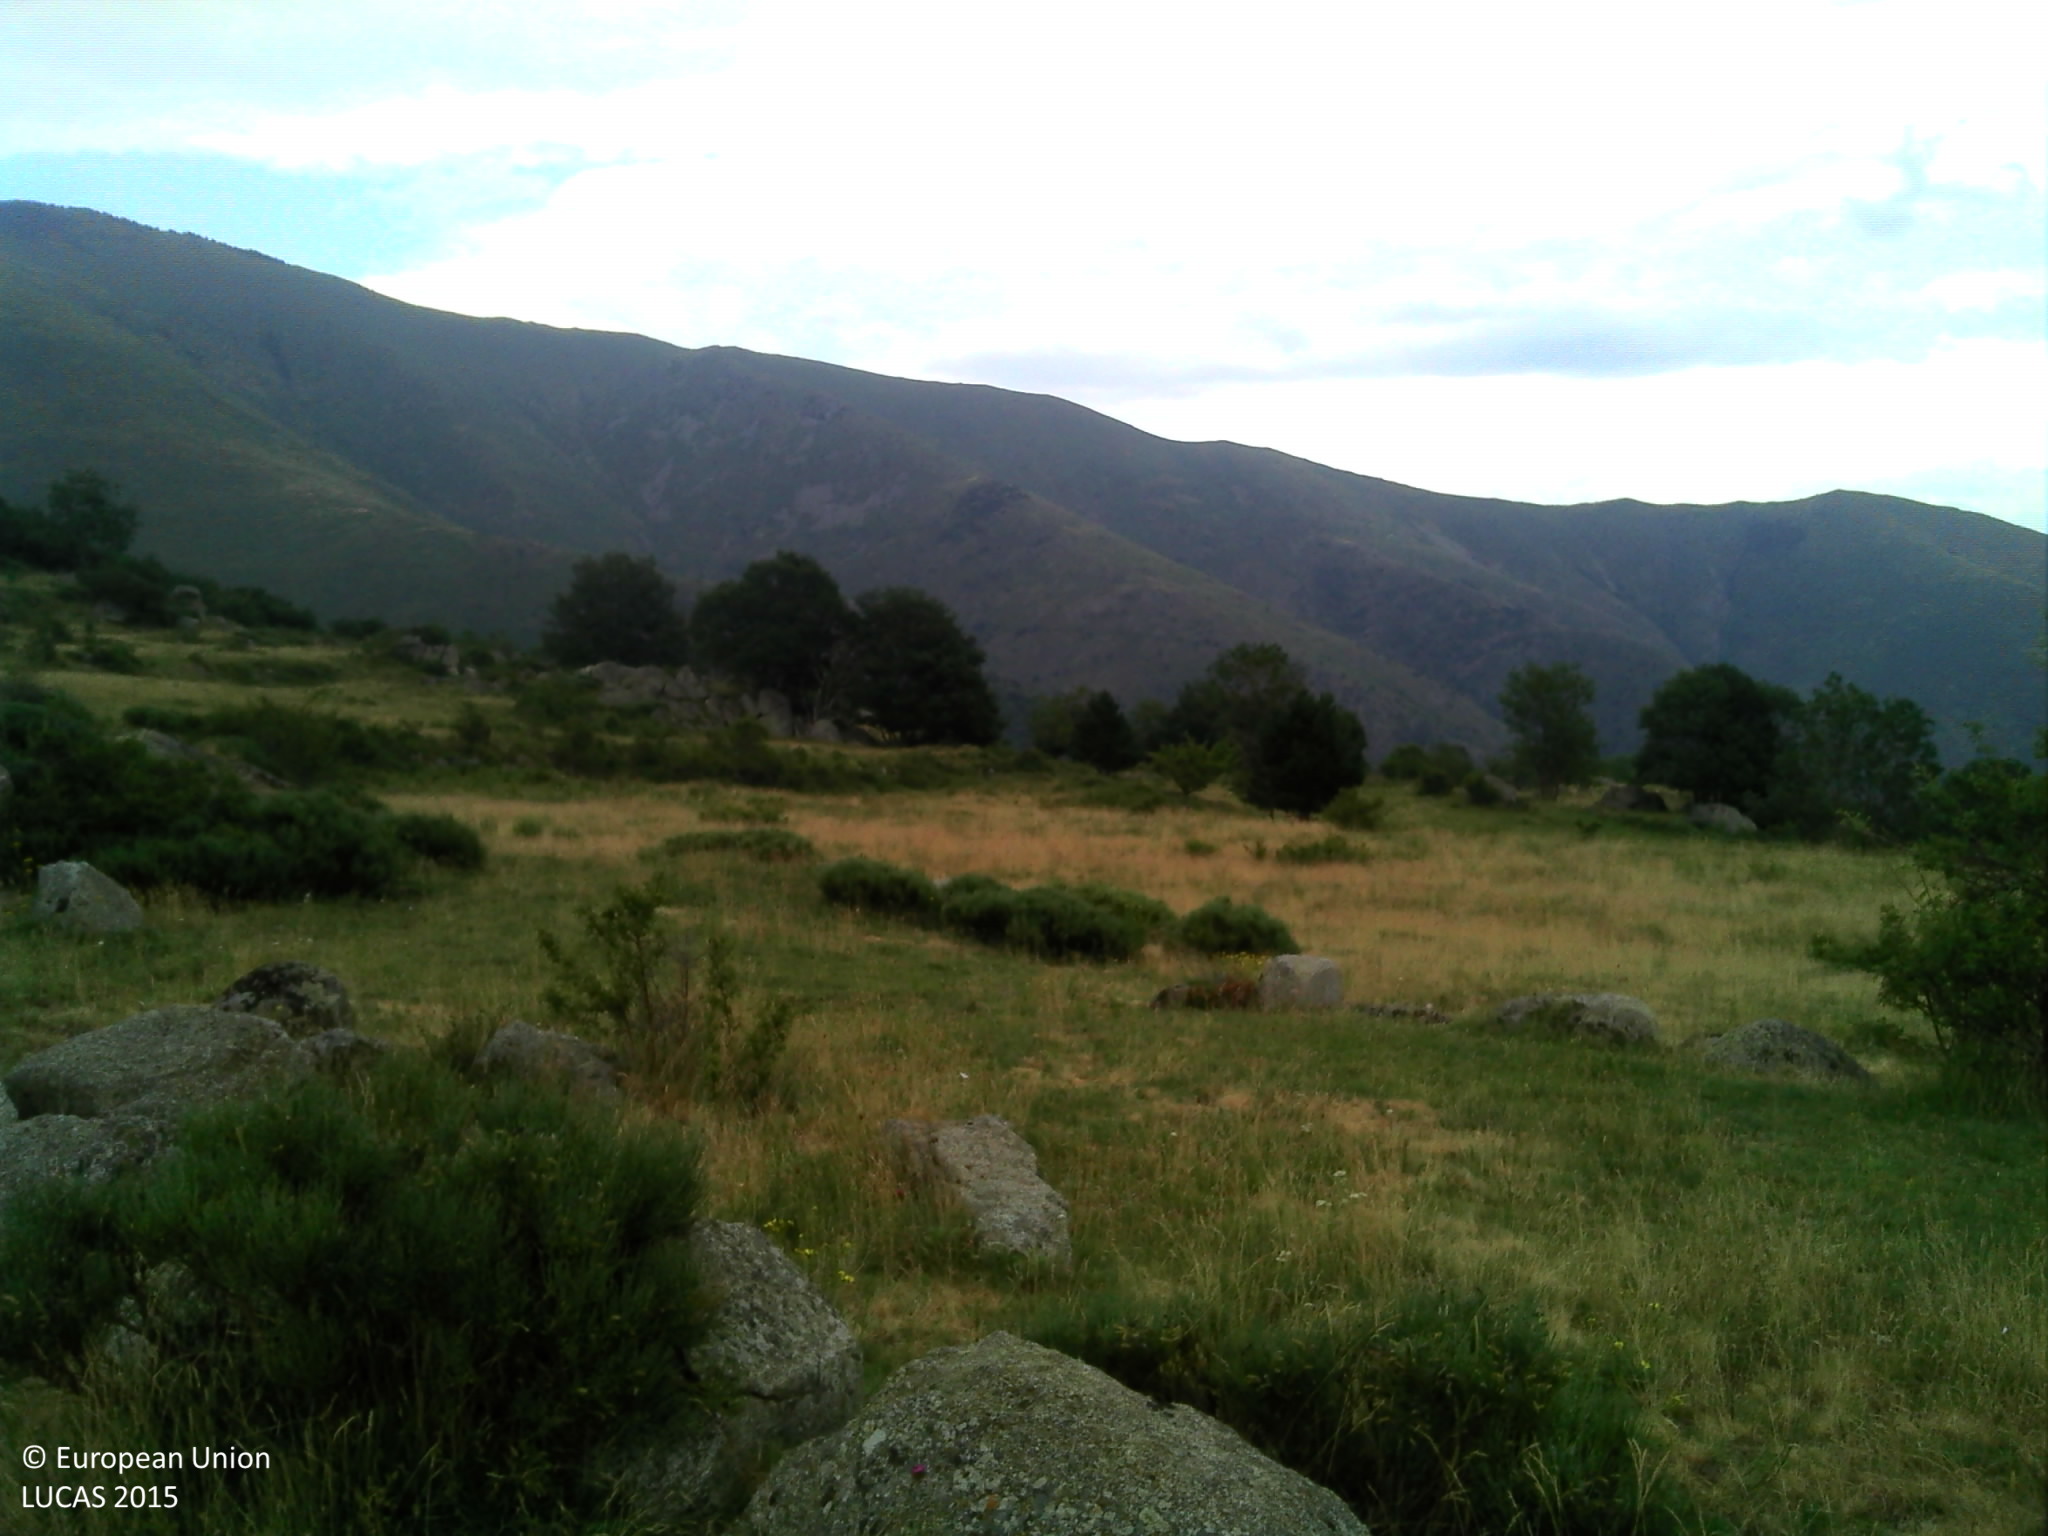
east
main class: Shrubland
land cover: Shrubland without tree cover
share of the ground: > 75 %
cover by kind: herbaceous plants 70 %, shrubs 20 %, consolidated bare surface 10 %
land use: Agriculture (excluding fallow land and kitchen gardens)
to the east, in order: Shrubland without tree cover; Rocks and stones; Shrubland without tree cover; Tracks; Grassland with sparse tree/shrub cover; Grassland without tree/shrub cover; Dry stone walls; Grassland with sparse tree/shrub cover; Dry stone walls; Single bushes/trees; Grassland without tree/shrub cover; Grassland with sparse tree/shrub cover; Broadleaved woodland; Grassland without tree/shrub cover; Dry stone walls; Grassland with sparse tree/shrub cover
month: July
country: FR
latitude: 42.5868
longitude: 2.1757
